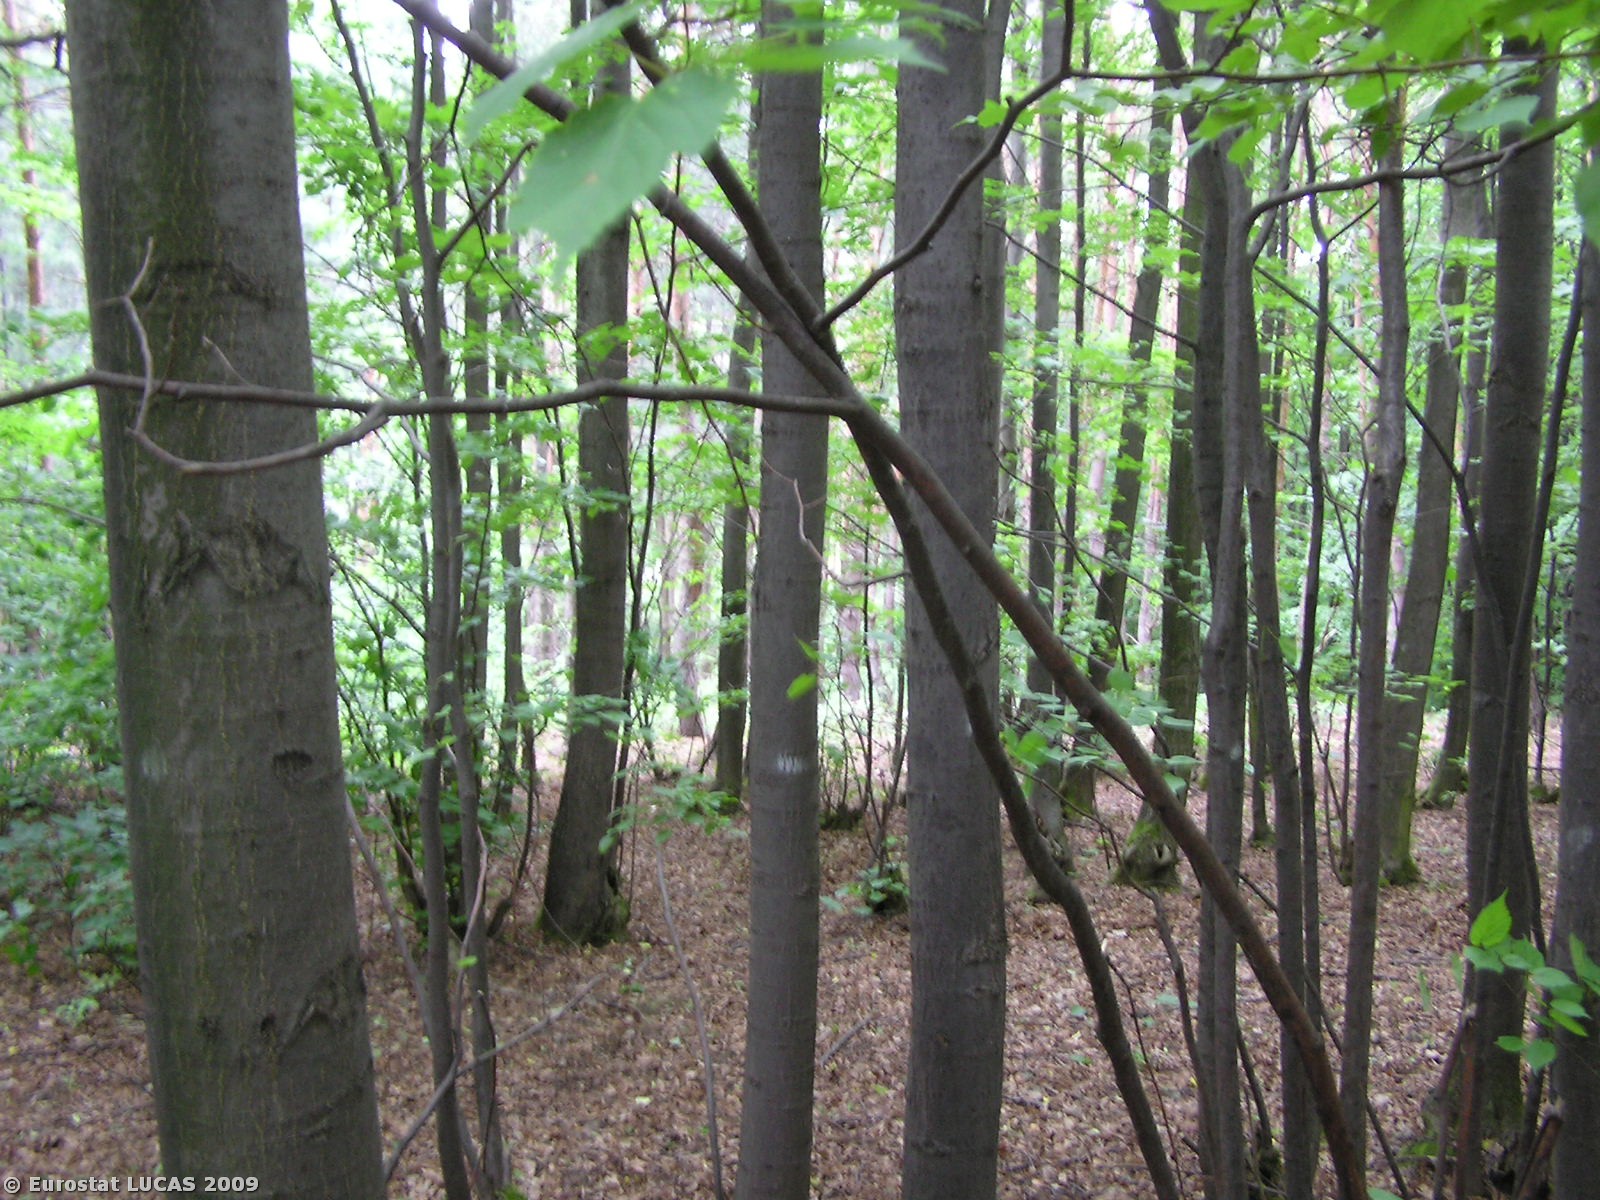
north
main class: Woodland
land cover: Broadleaved woodland
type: beech forest
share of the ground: > 75 %
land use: Forestry
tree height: > 5 m
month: June
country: CZ
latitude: 50.2160
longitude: 17.6511
